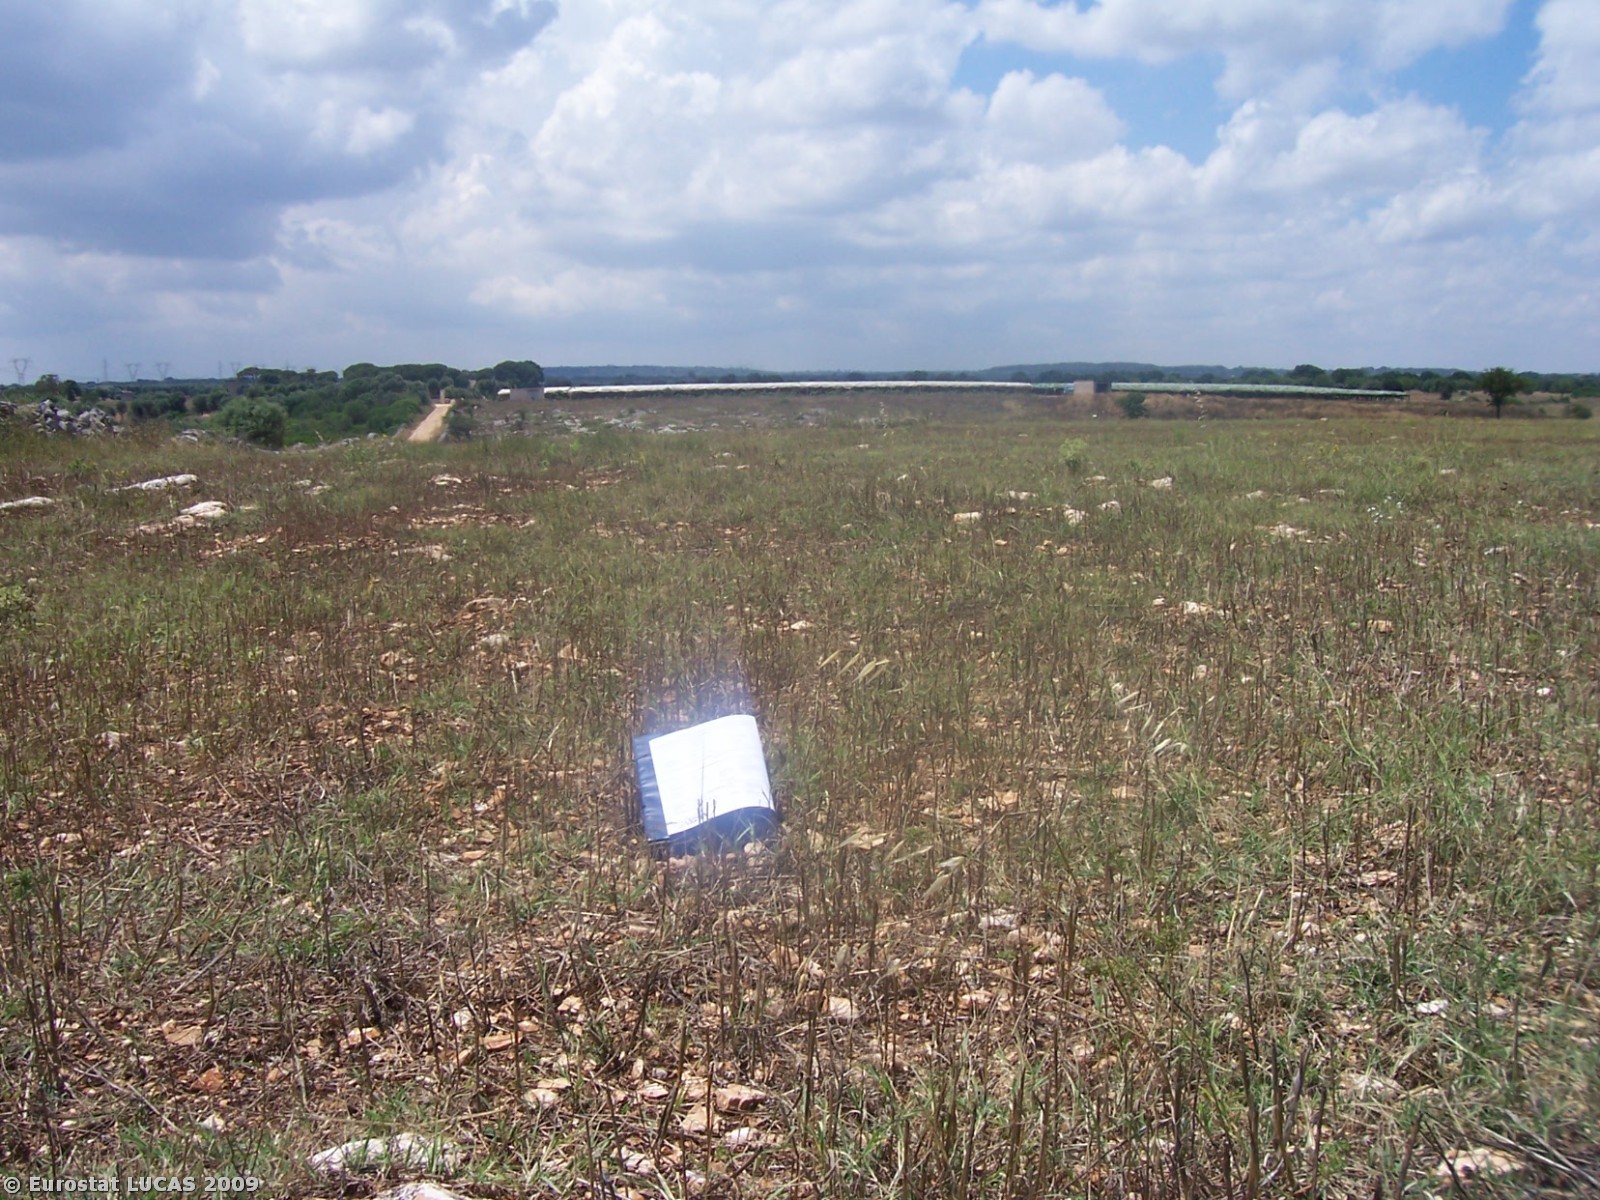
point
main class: Cropland
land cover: Mixed cereals for fodder
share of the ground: < 10 %
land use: Agriculture (excluding fallow land and kitchen gardens)
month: July
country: IT
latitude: 40.5954
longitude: 17.5272
